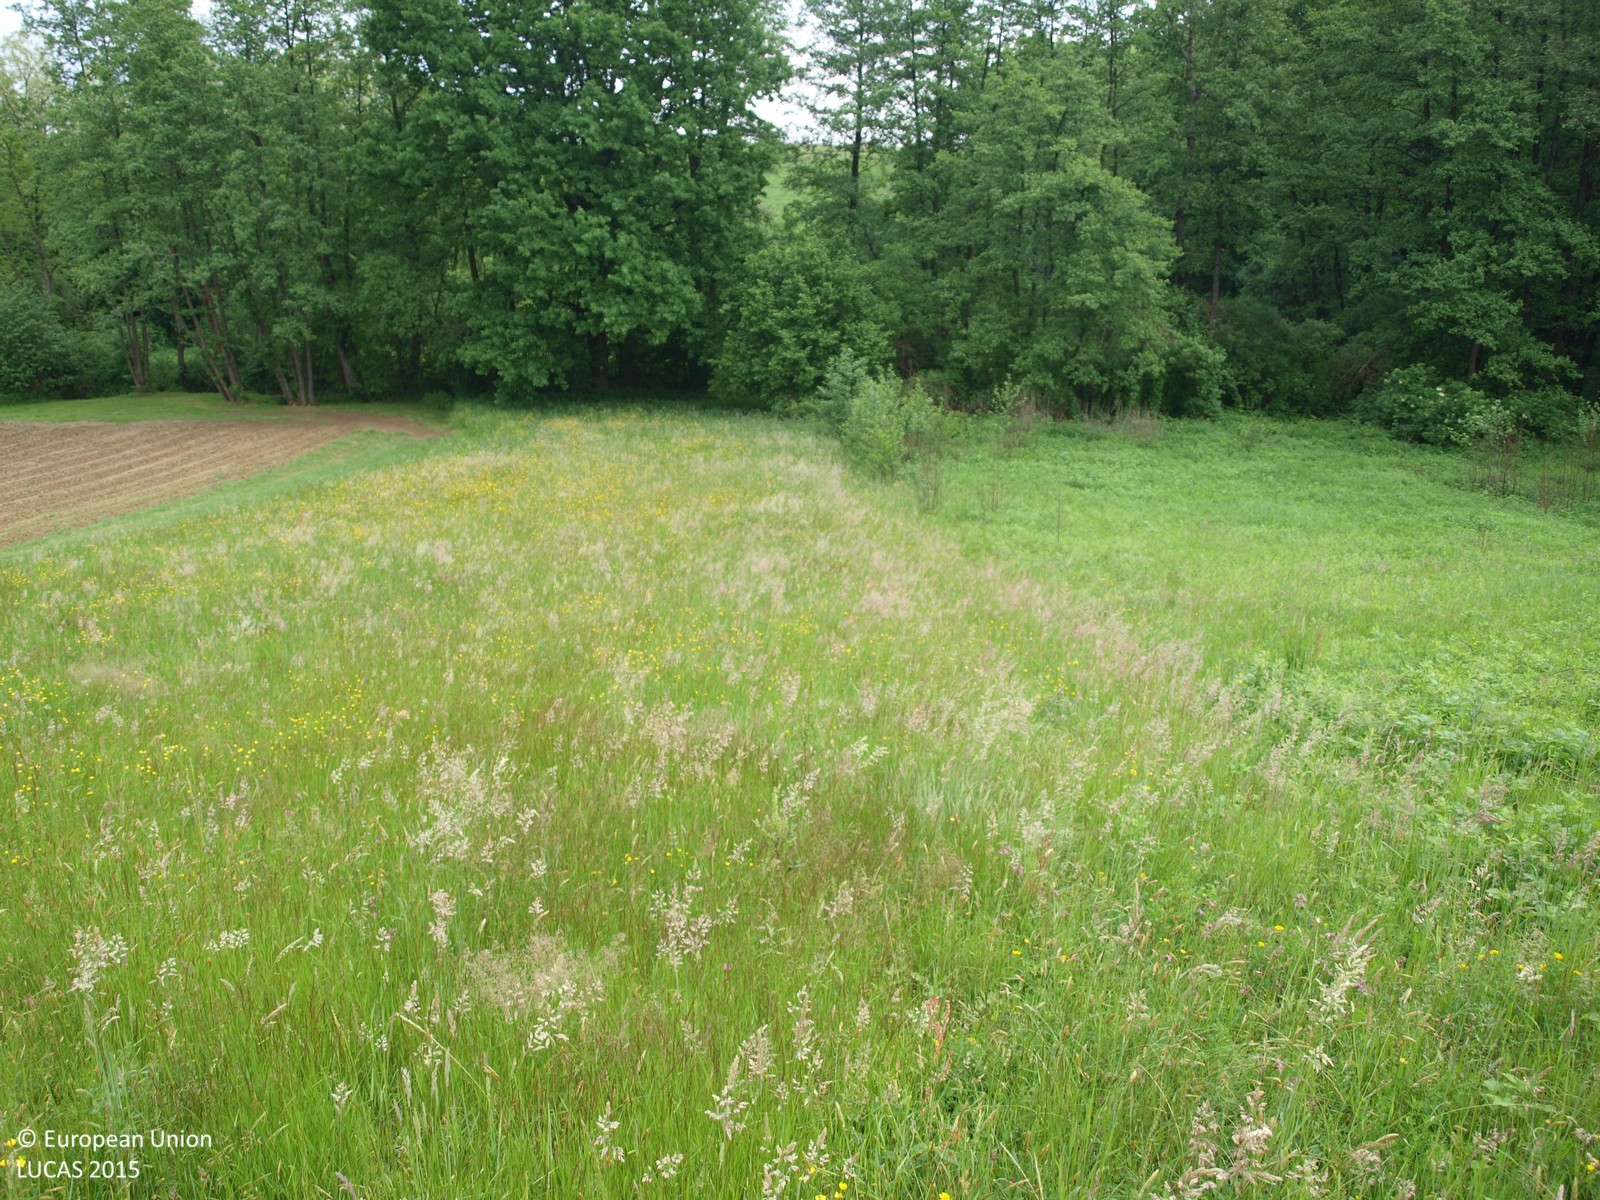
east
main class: Grassland
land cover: Grassland without tree/shrub cover
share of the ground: > 75 %
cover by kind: herbaceous plants 100 %
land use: Agriculture (excluding fallow land and kitchen gardens)
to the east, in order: Grassland without tree/shrub cover; Broadleaved woodland; Rivers and streams; Broadleaved woodland; Spontaneously vegetated surfaces; Tracks; Spontaneously vegetated surfaces
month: May
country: HR
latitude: 46.0650
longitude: 16.1655
